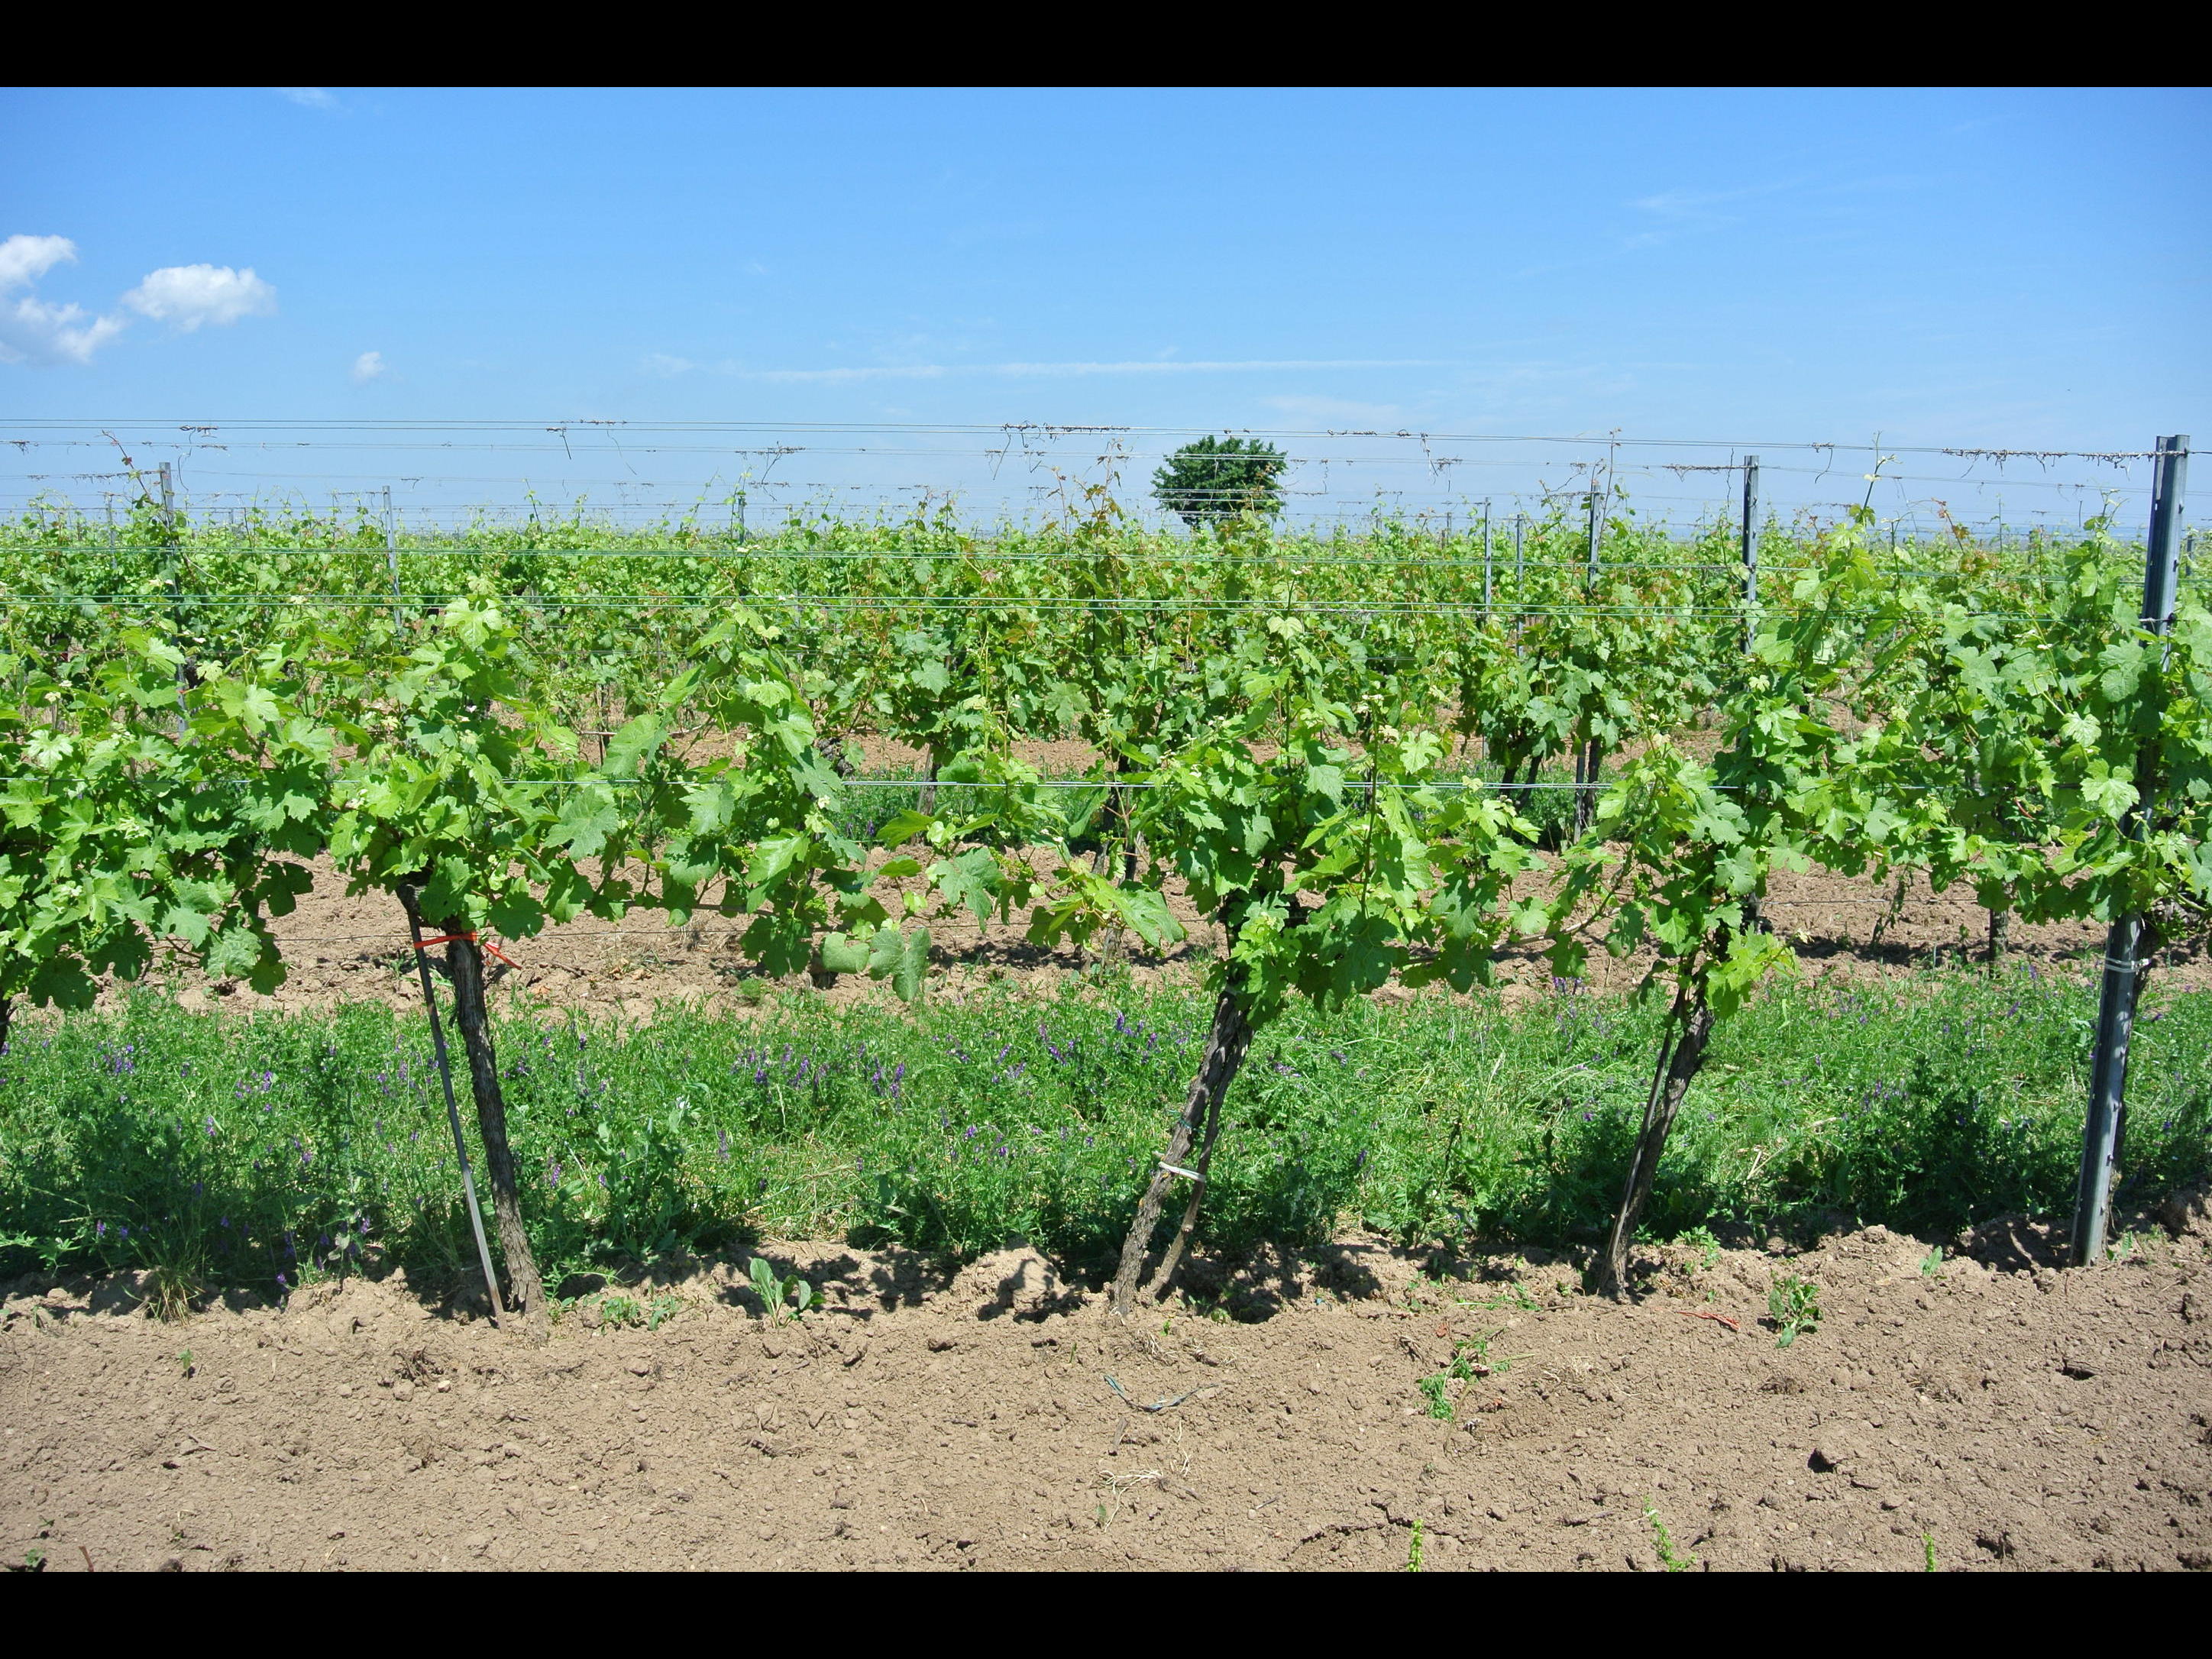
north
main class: Cropland
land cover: Temporary grasslands
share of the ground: > 75 %
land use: Agriculture (excluding fallow land and kitchen gardens)
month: June
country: AT
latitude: 47.8066
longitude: 16.6415
